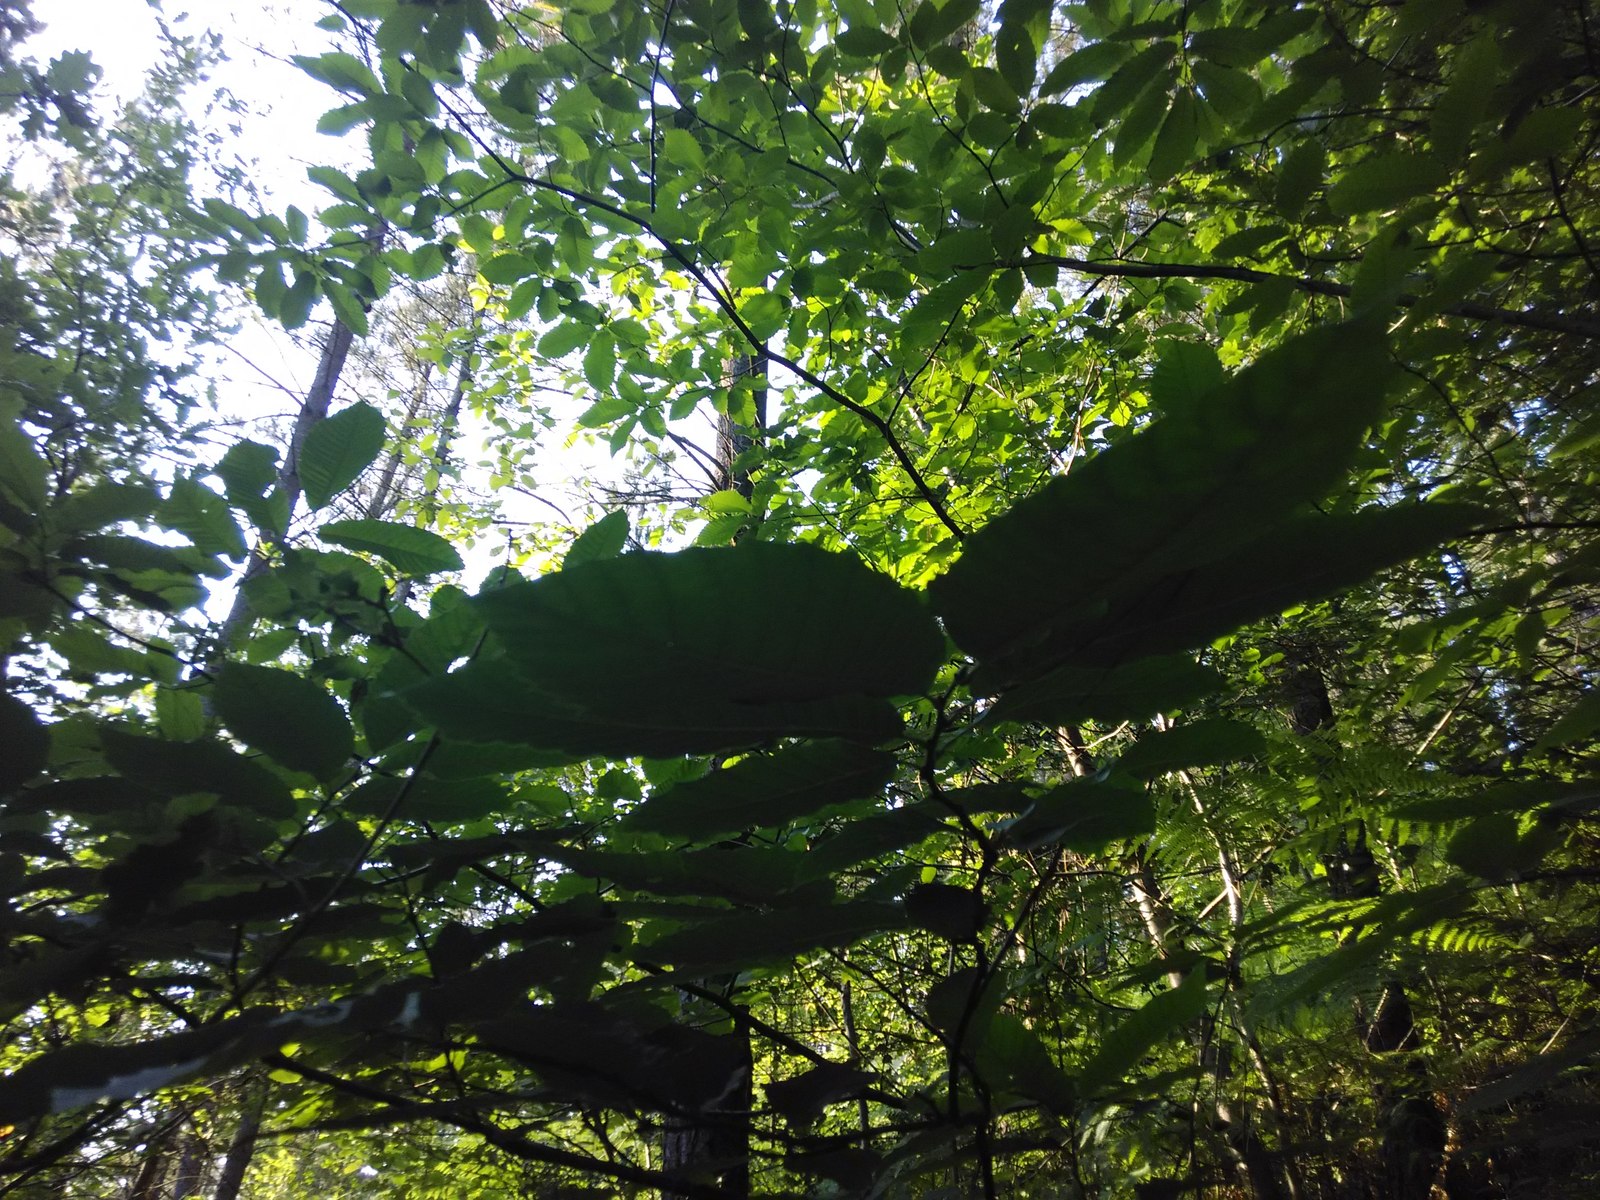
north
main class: Woodland
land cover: Other mixed woodland
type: acidophilous oak and oak-birch forest
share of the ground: > 75 %
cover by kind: coniferous forest trees 40 %, broadleaved forest trees 35 %, herbaceous plants 15 %, unconsolidated bare surface 10 %
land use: Forestry
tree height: > 5 m
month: June
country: ES
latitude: 43.0667
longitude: -2.4659
